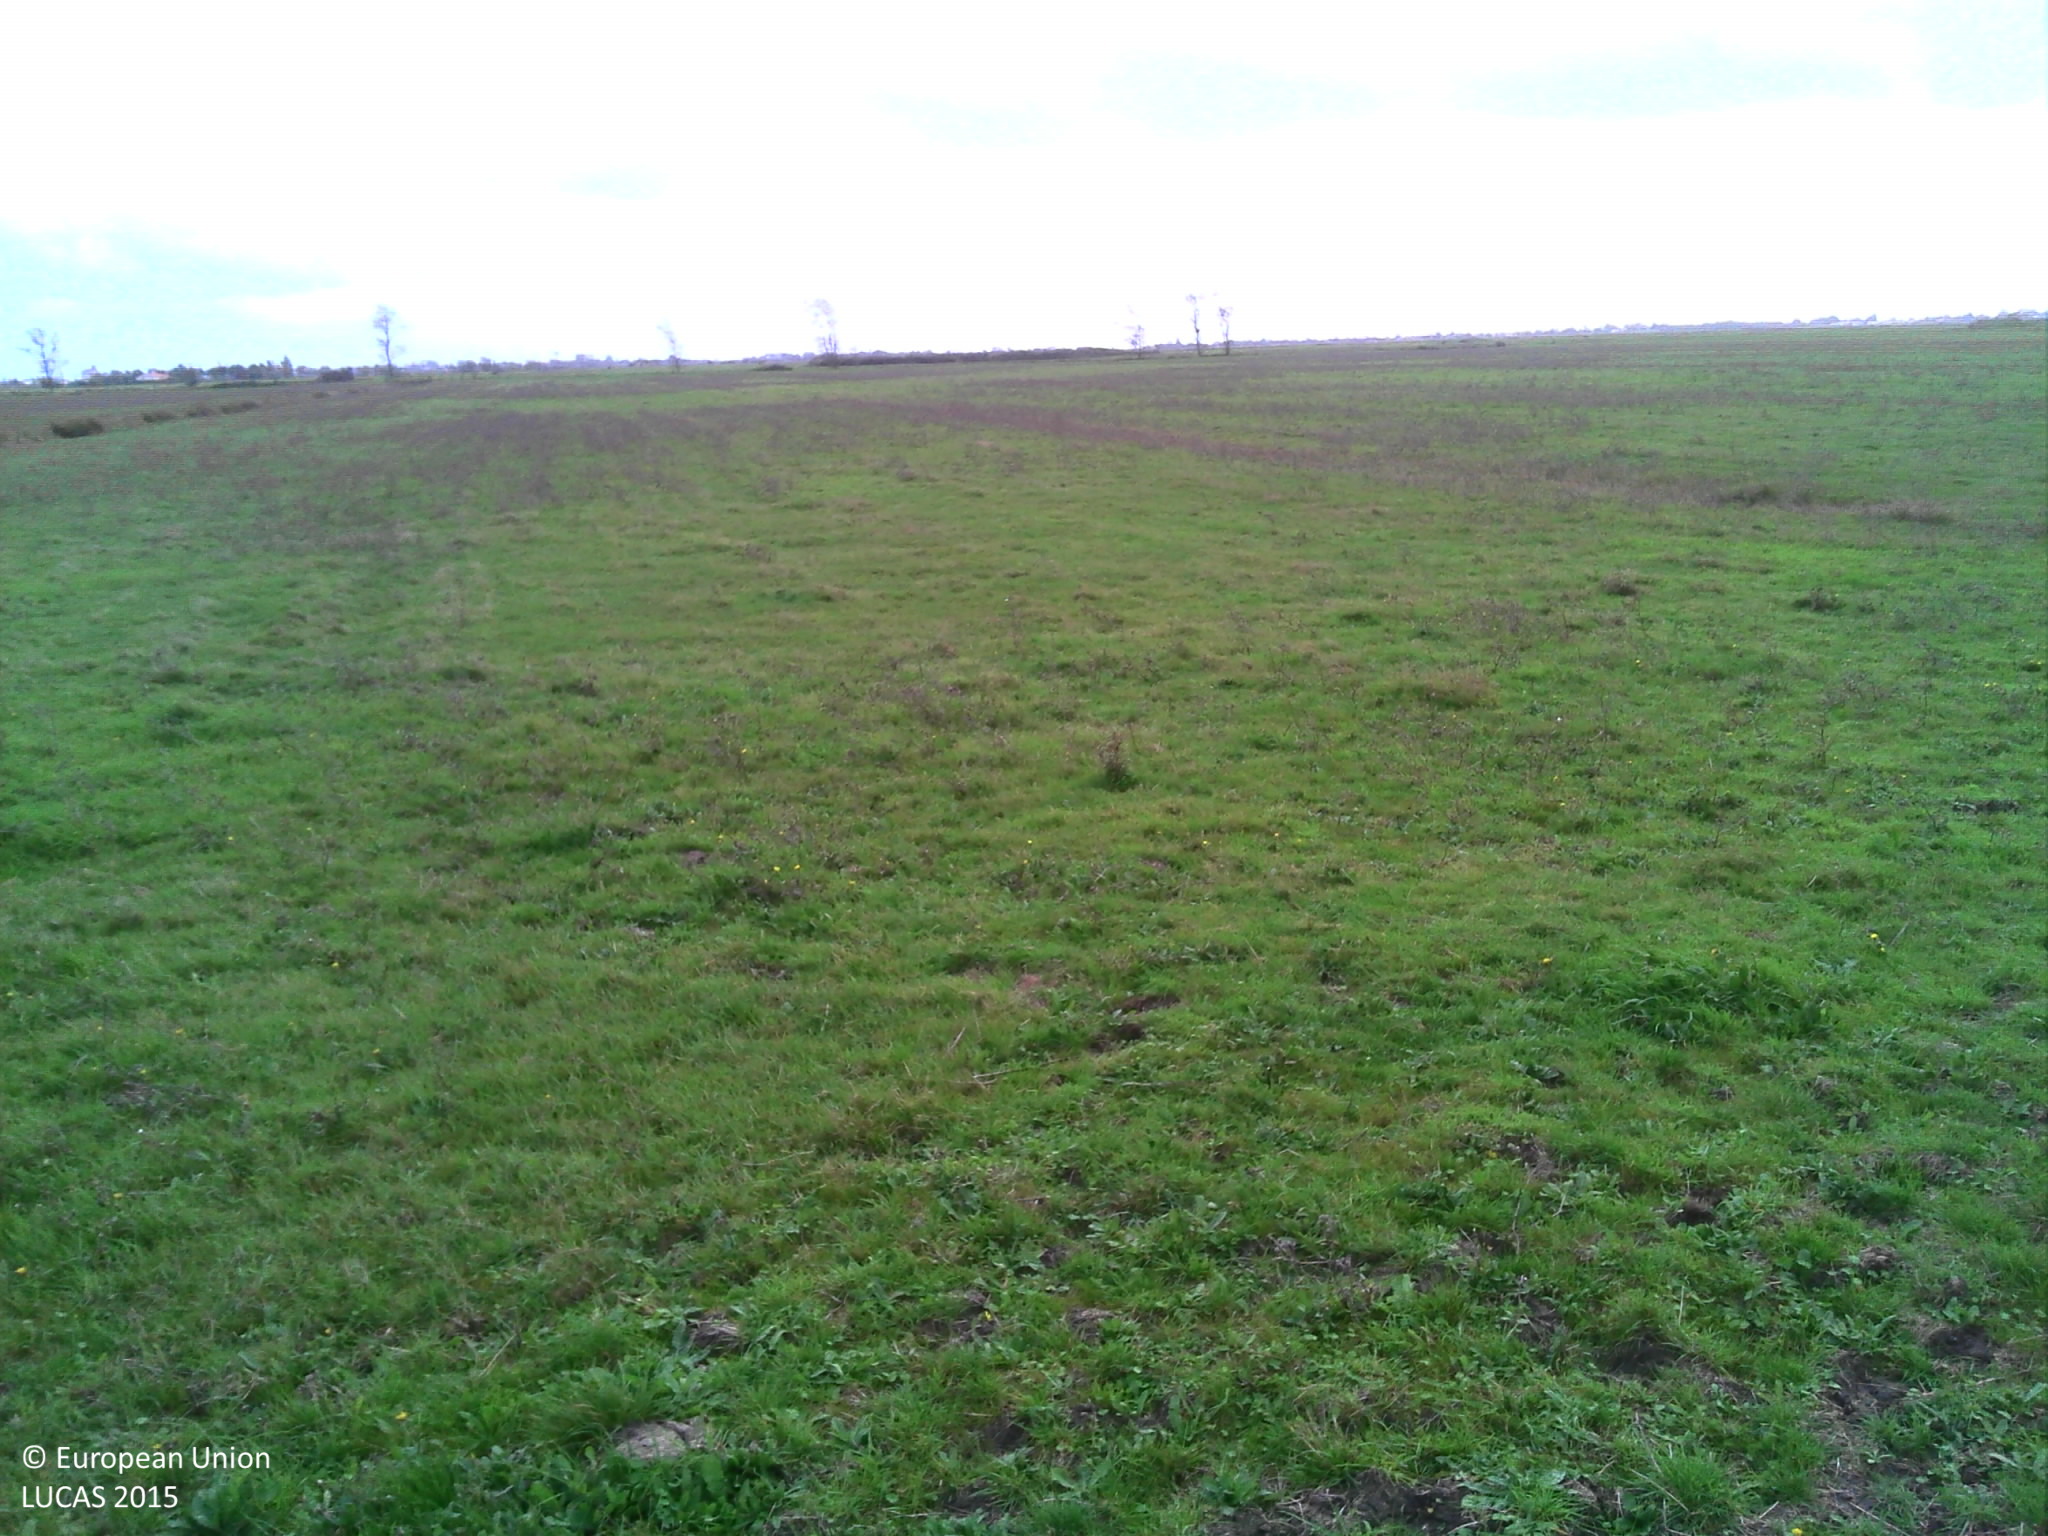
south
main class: Grassland
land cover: Grassland without tree/shrub cover
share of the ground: > 75 %
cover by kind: herbaceous plants 100 %
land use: Agriculture (excluding fallow land and kitchen gardens)
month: October
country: FR
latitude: 46.4074
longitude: -1.1026
